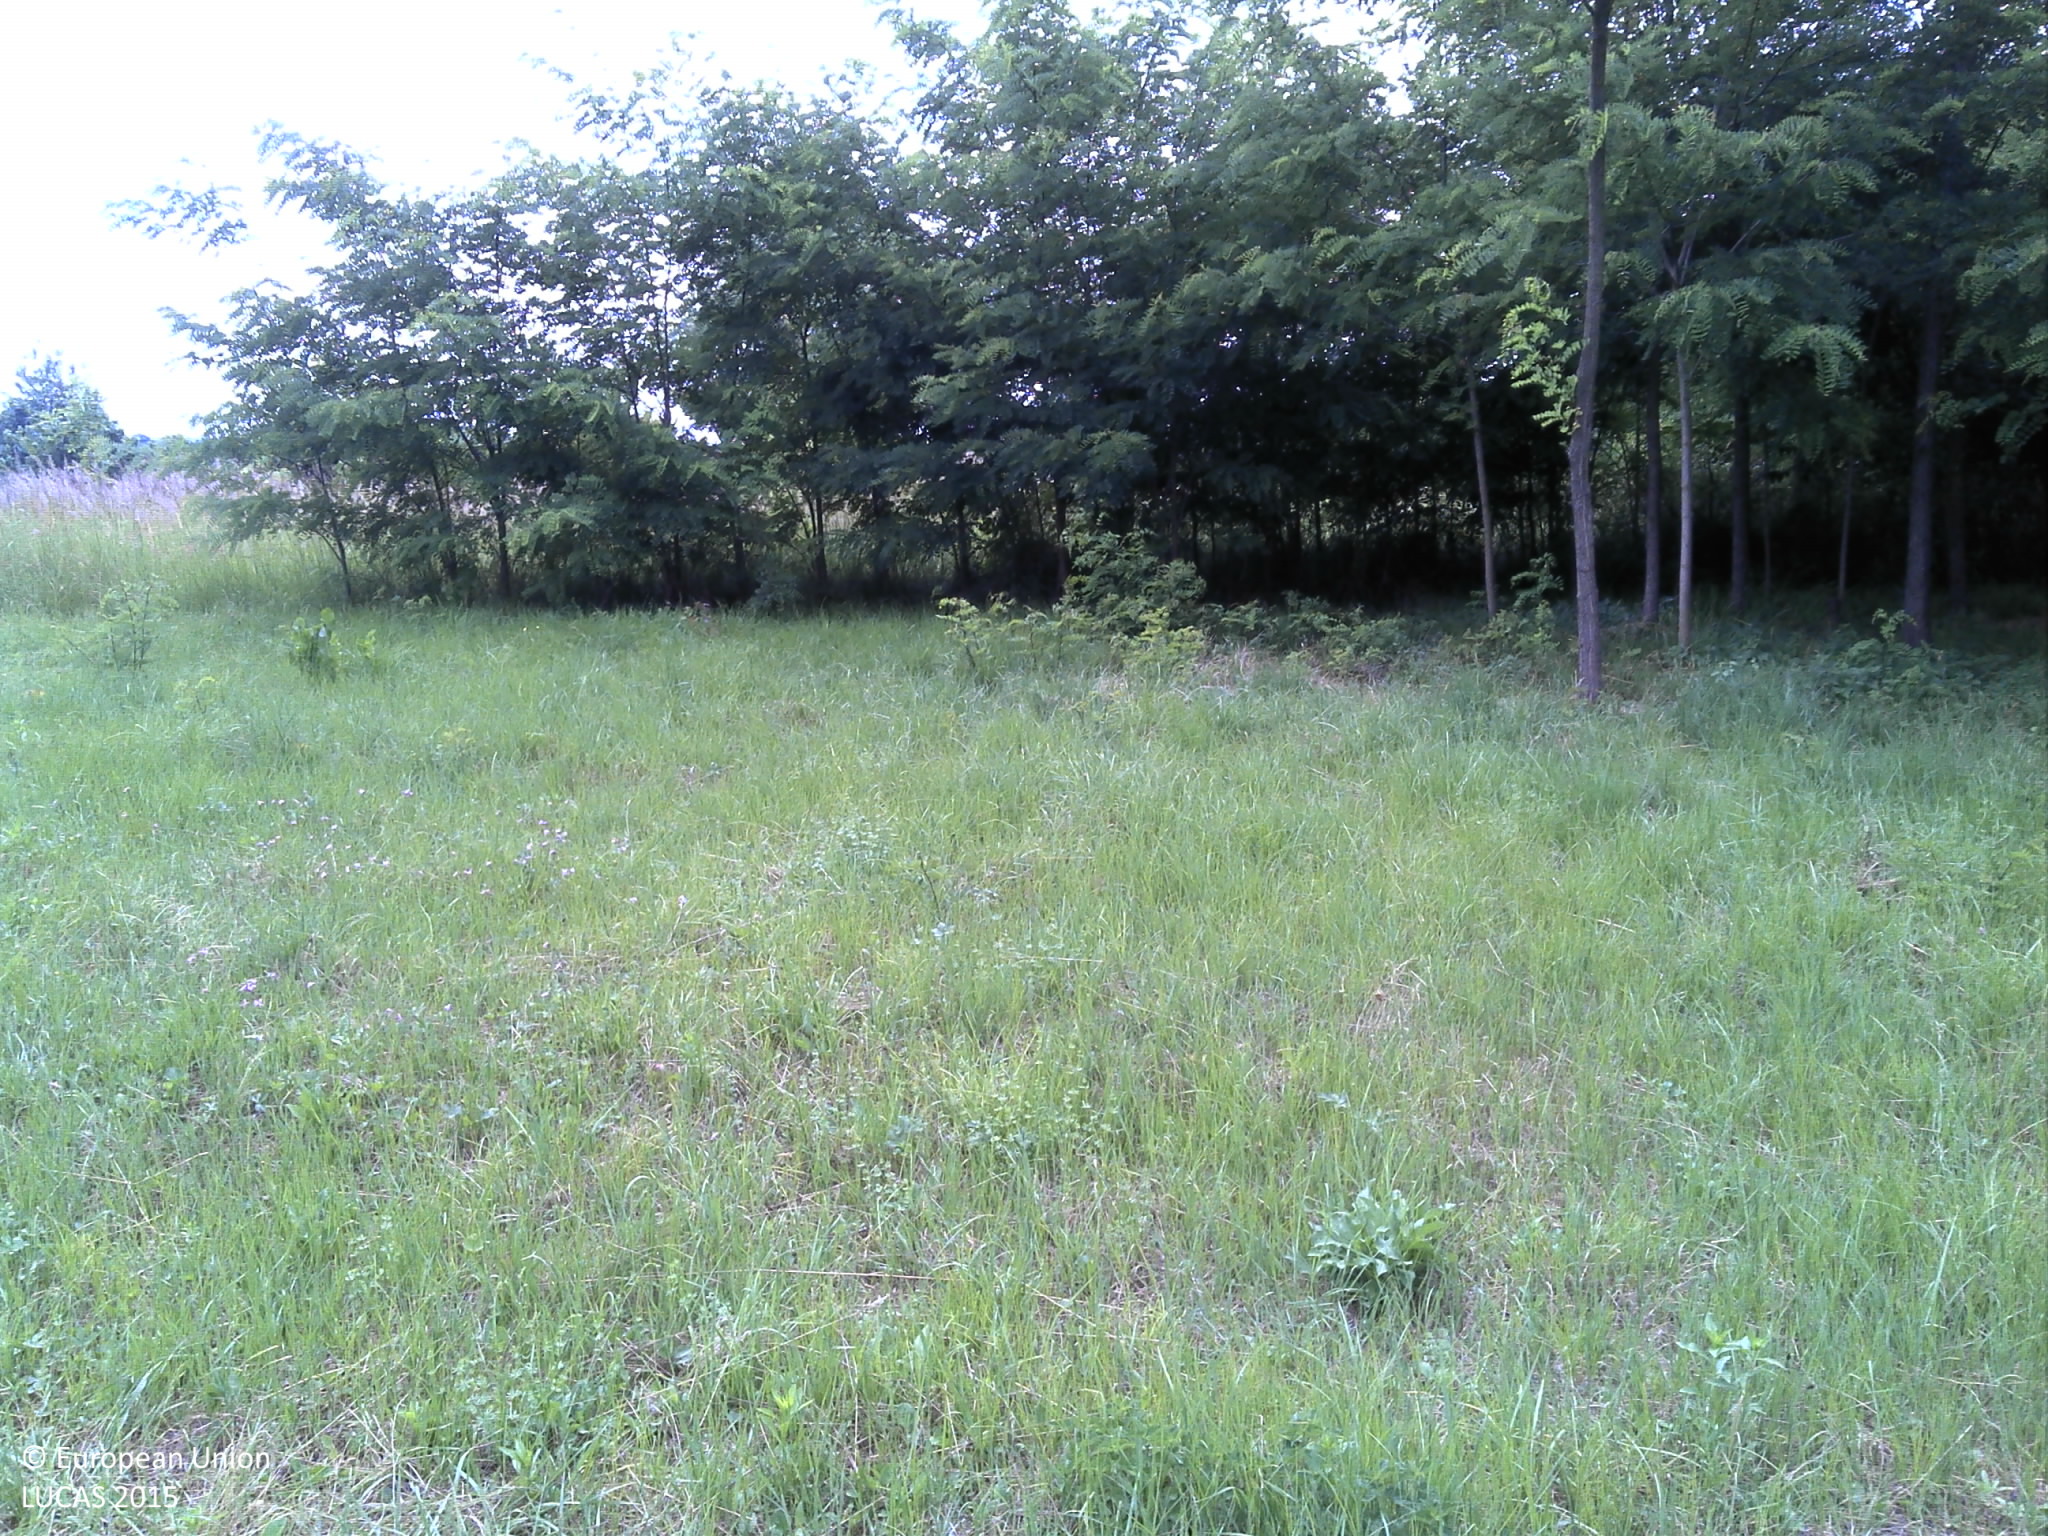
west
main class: Grassland
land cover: Grassland with sparse tree/shrub cover
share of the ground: > 75 %
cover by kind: herbaceous plants 90 %, broadleaved forest trees 5 %, shrubs 5 %
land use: Semi-natural and natural areas not in use
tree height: < 5 m
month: June
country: HR
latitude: 45.6912
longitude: 18.2111
